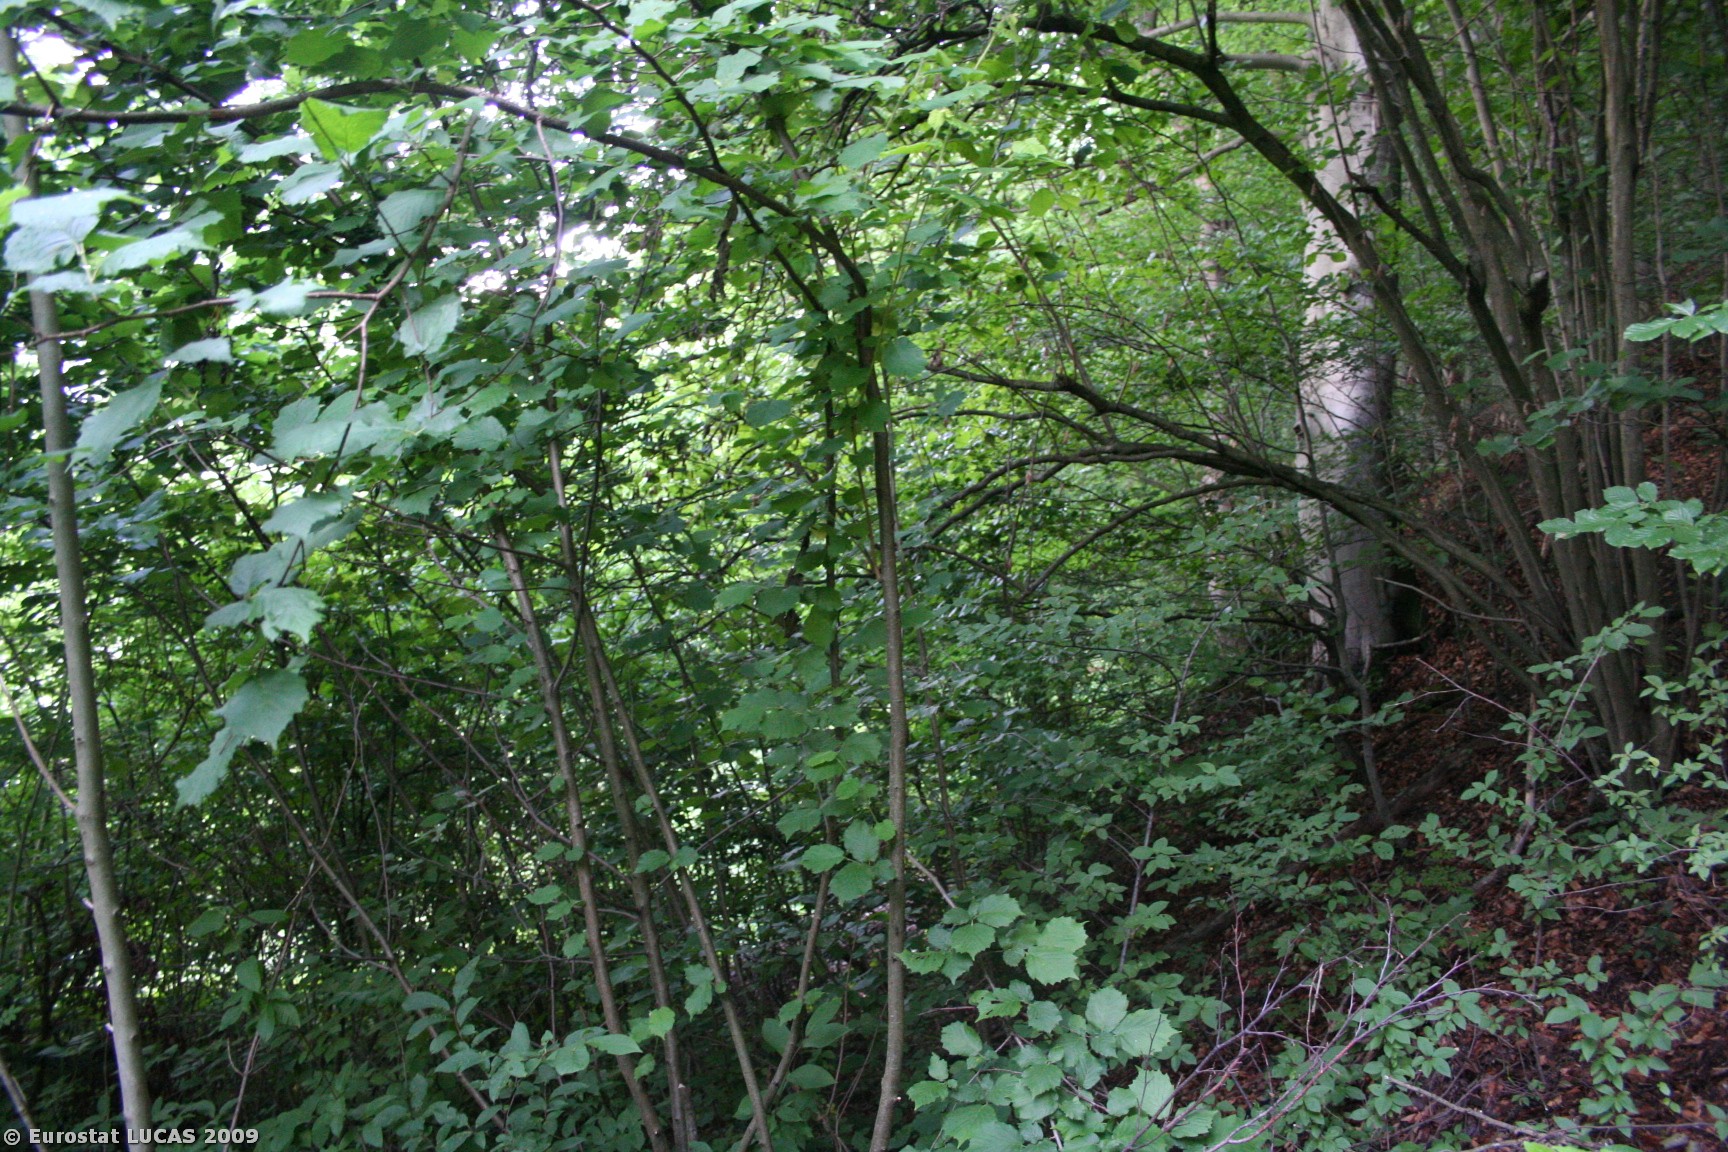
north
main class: Woodland
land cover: Broadleaved woodland
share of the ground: > 75 %
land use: Forestry
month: June
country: AT
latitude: 47.4748
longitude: 13.1961
